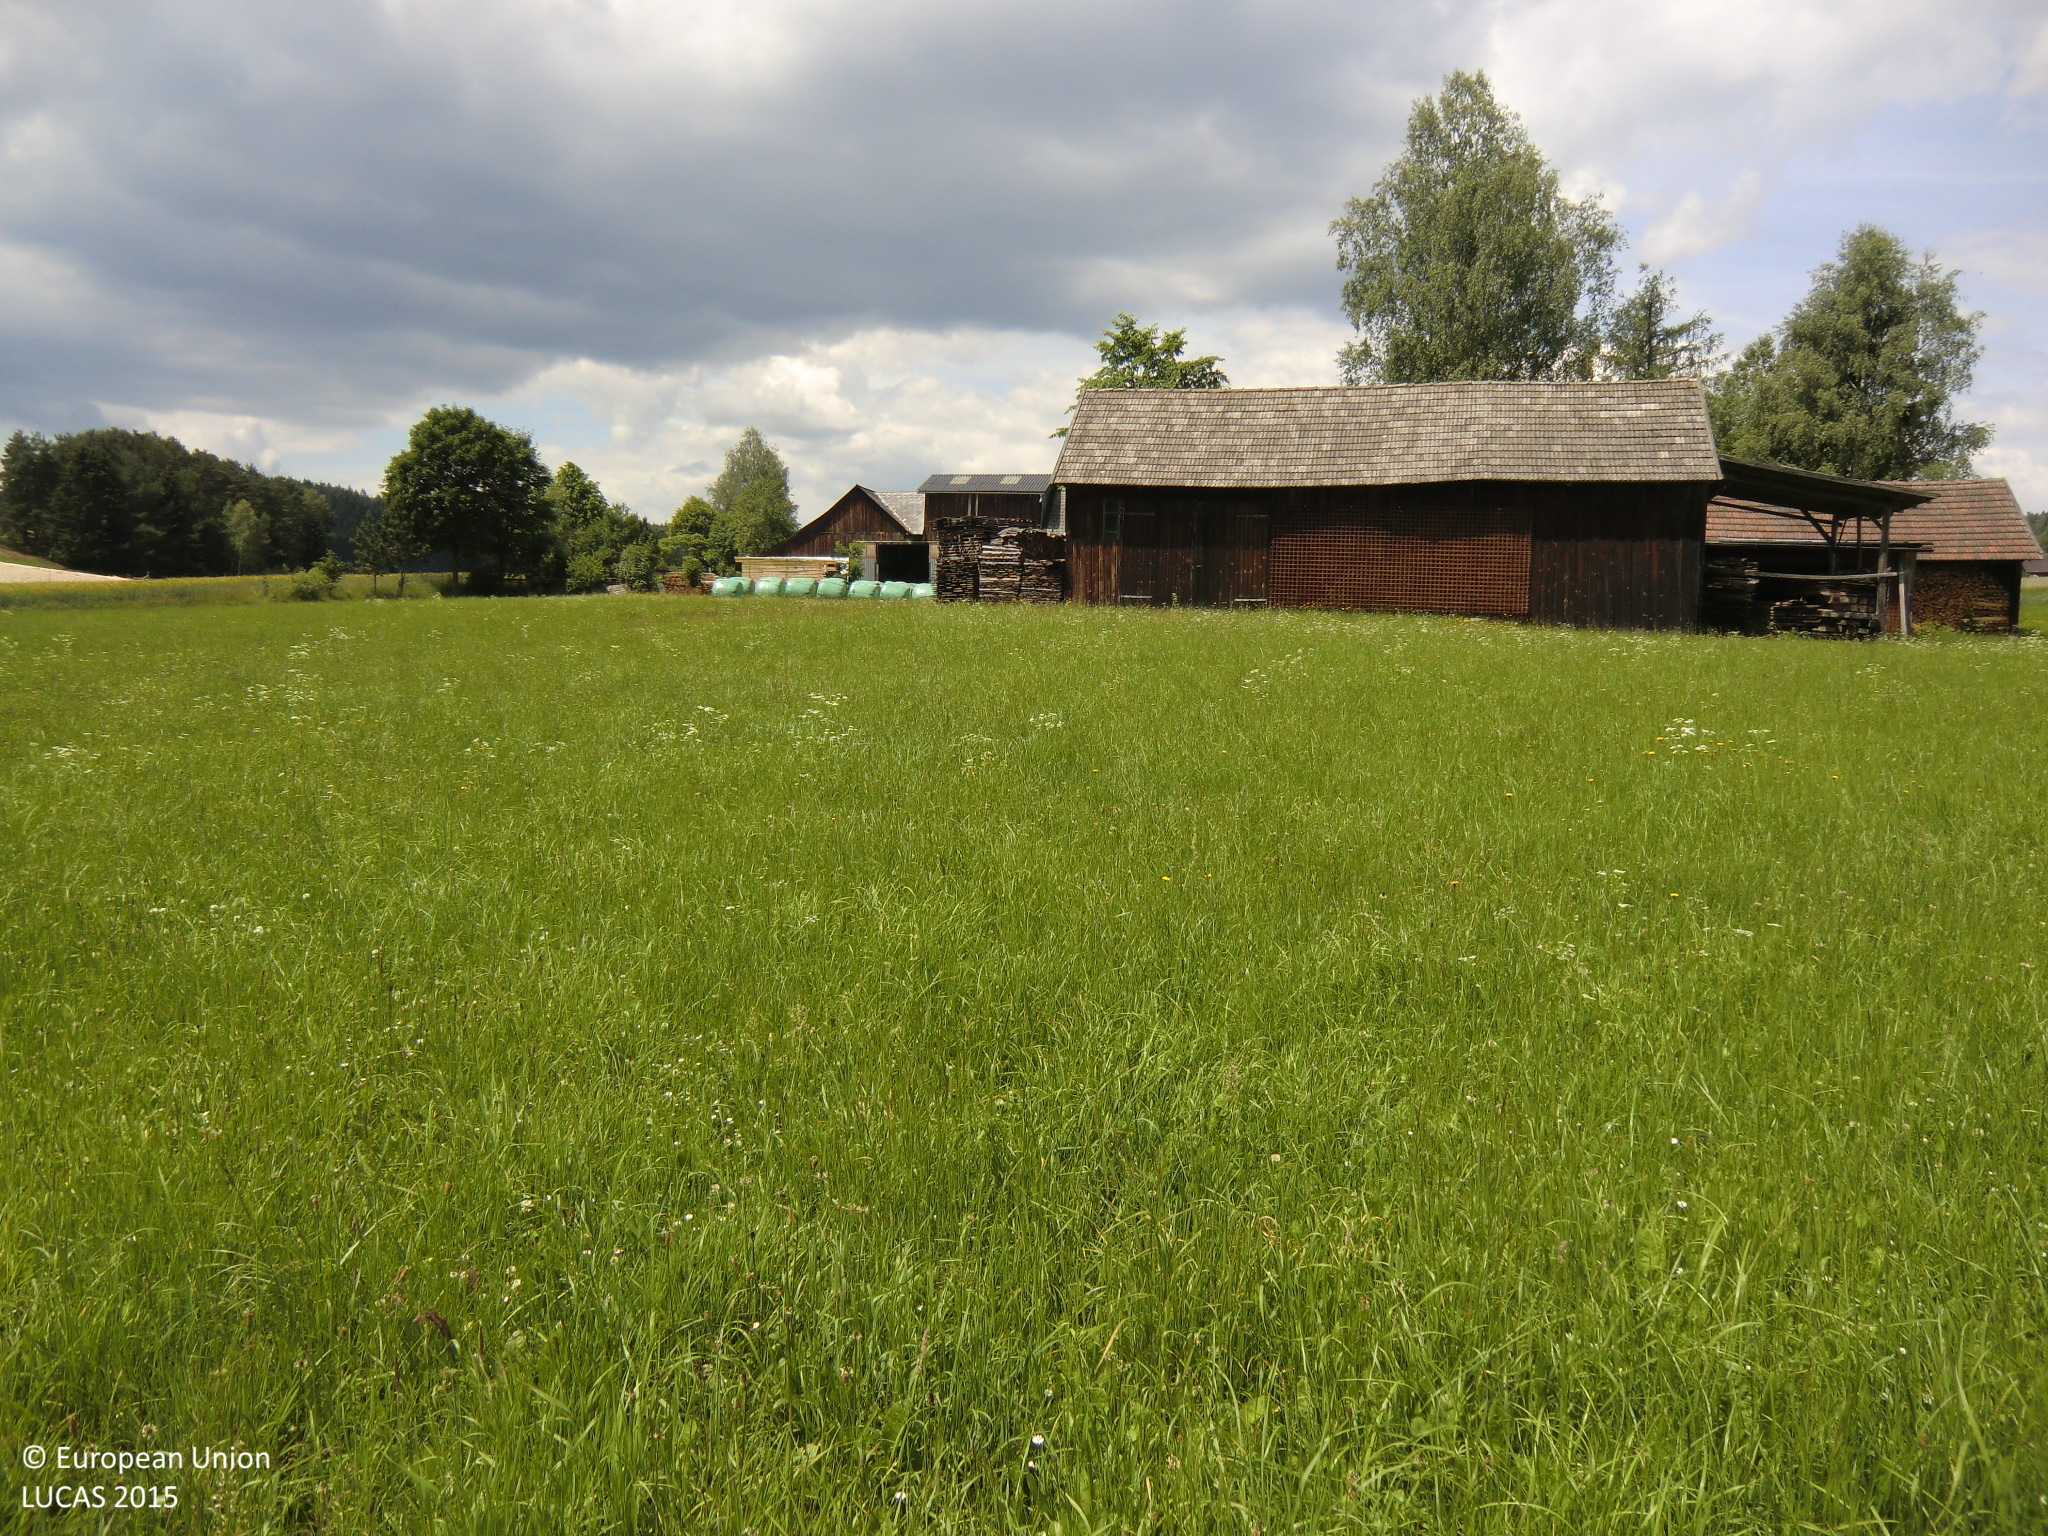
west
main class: Grassland
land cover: Grassland without tree/shrub cover
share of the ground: > 75 %
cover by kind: herbaceous plants 100 %
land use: Agriculture (excluding fallow land and kitchen gardens)
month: June
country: AT
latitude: 48.4865
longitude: 15.0484
